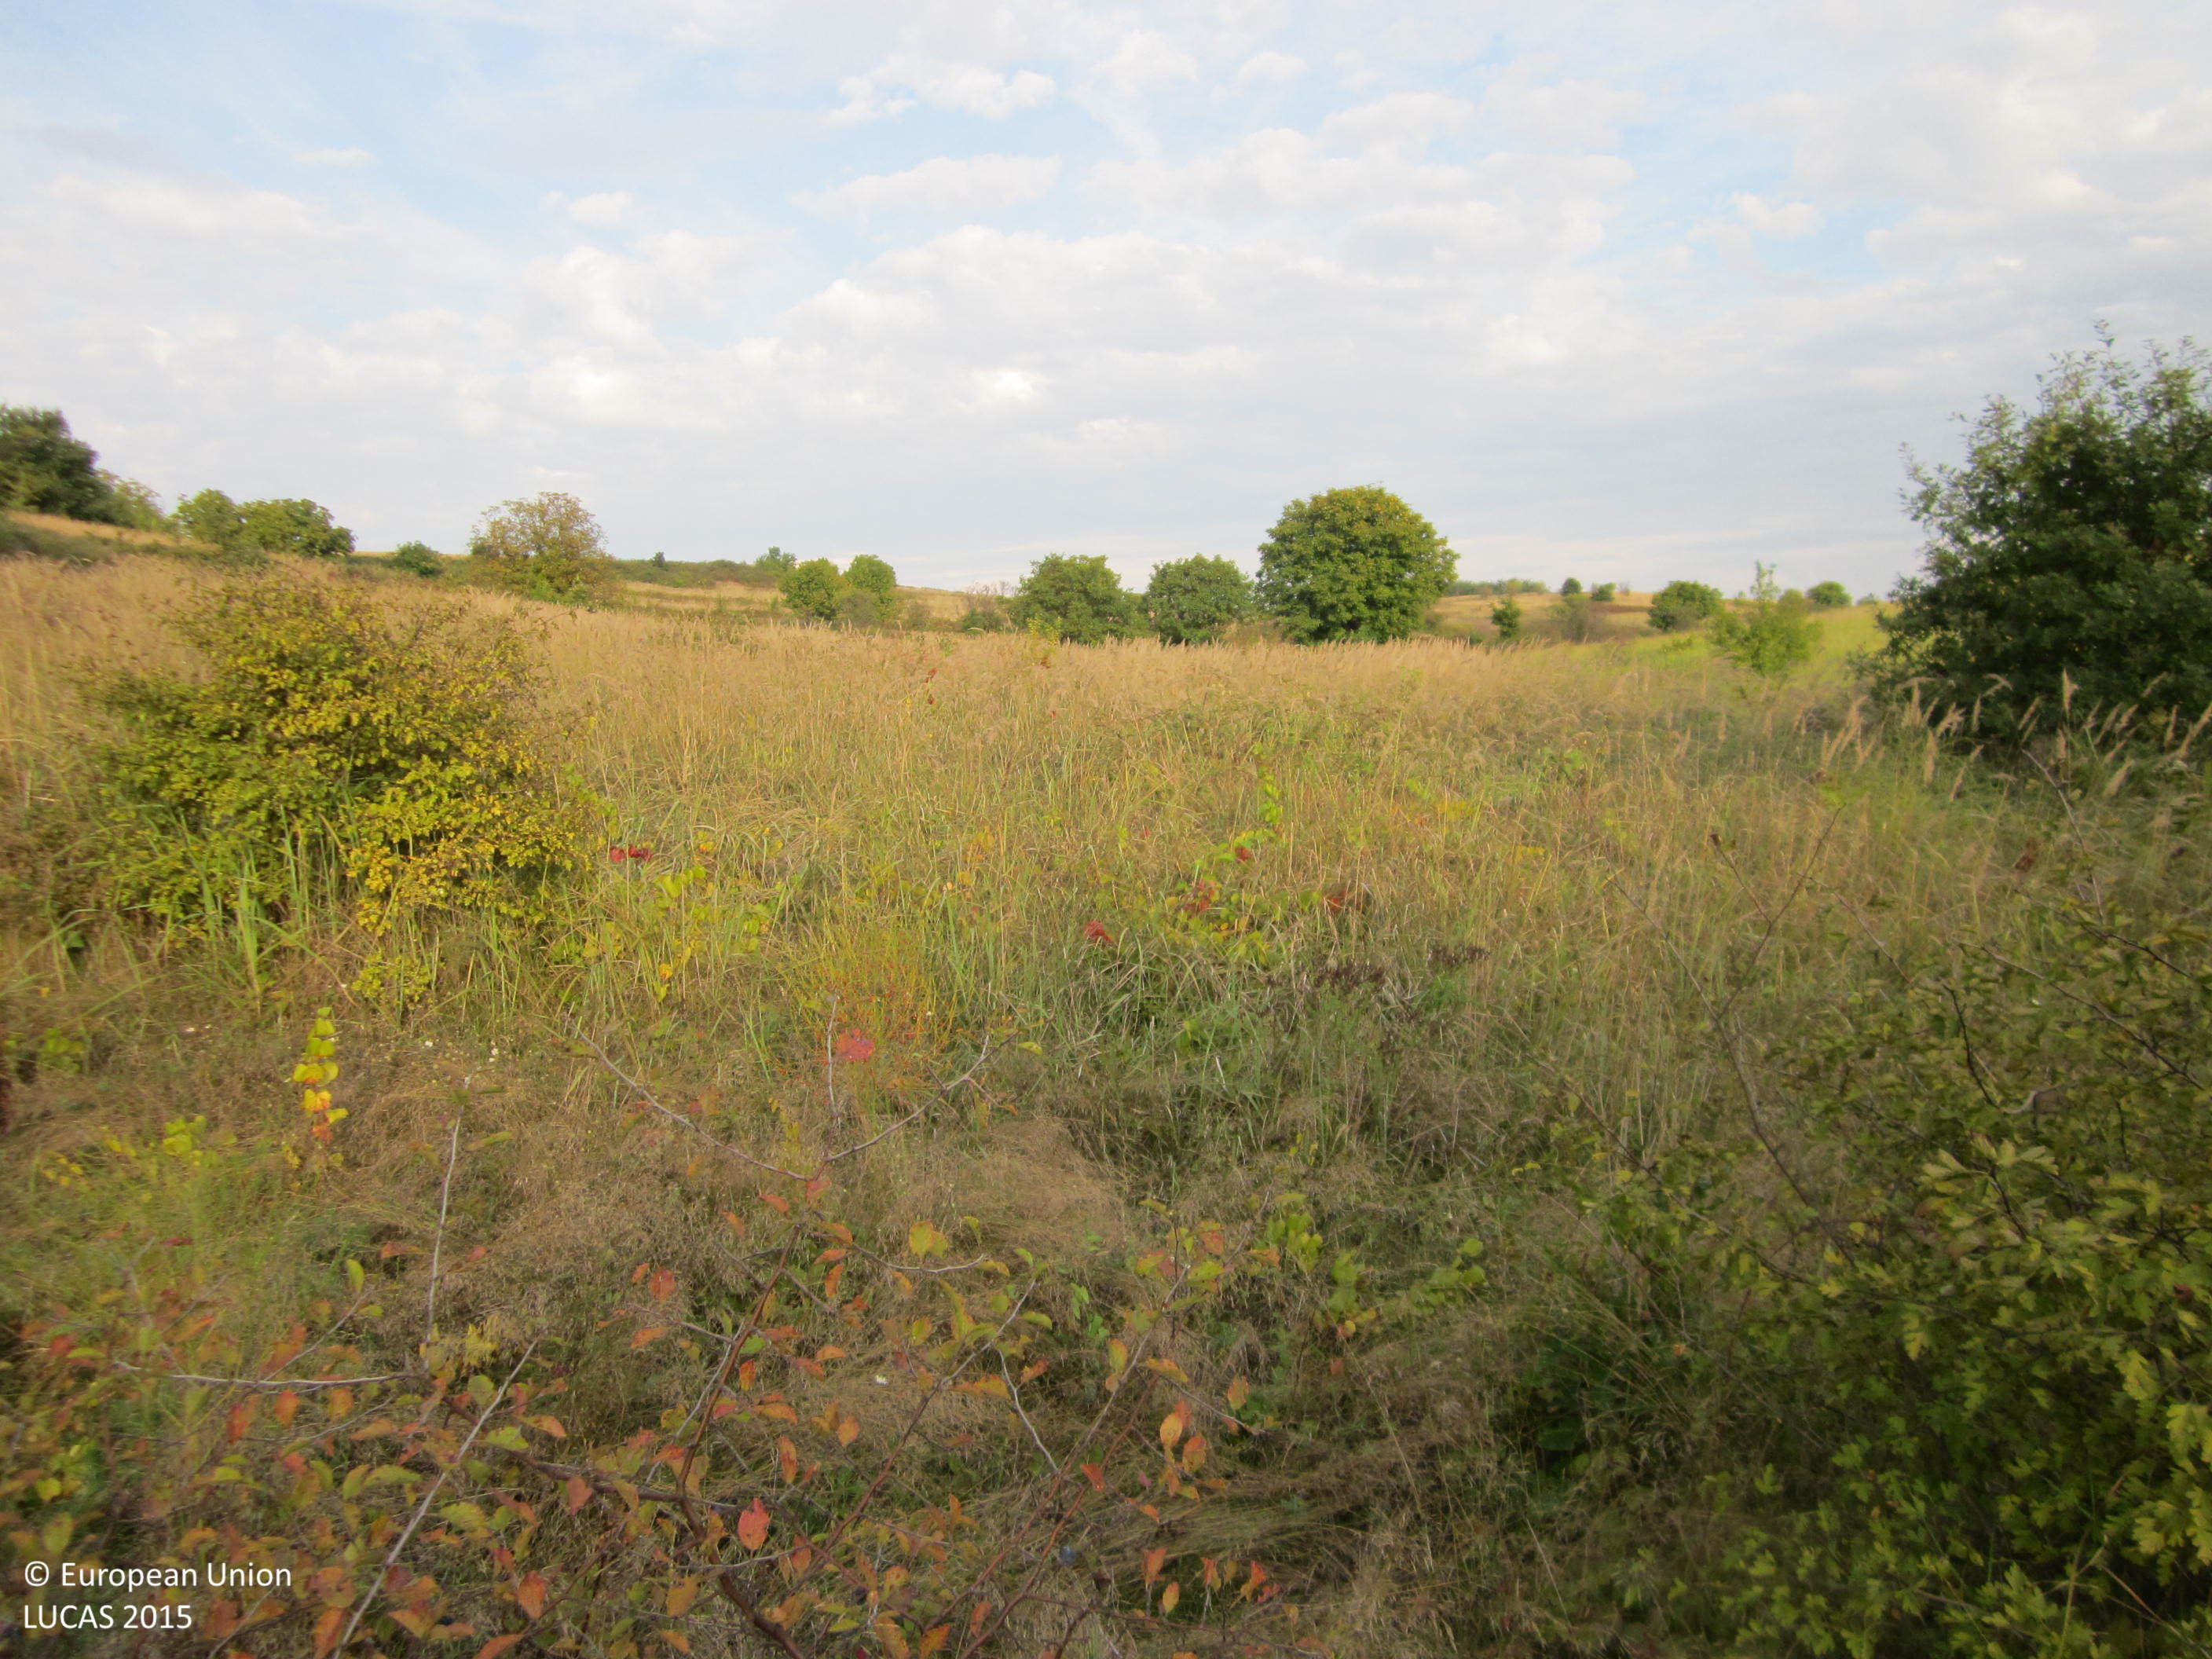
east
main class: Shrubland
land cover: Shrubland with sparse tree cover
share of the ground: 50 - 75 %
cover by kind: shrubs 70 %, herbaceous plants 25 %, broadleaved forest trees 5 %
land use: Semi-natural and natural areas not in use
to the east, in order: Shrubland with sparse tree cover; Vineyards; Tracks; Grassland with sparse tree/shrub cover
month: October
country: BG
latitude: 42.7244
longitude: 26.7215
